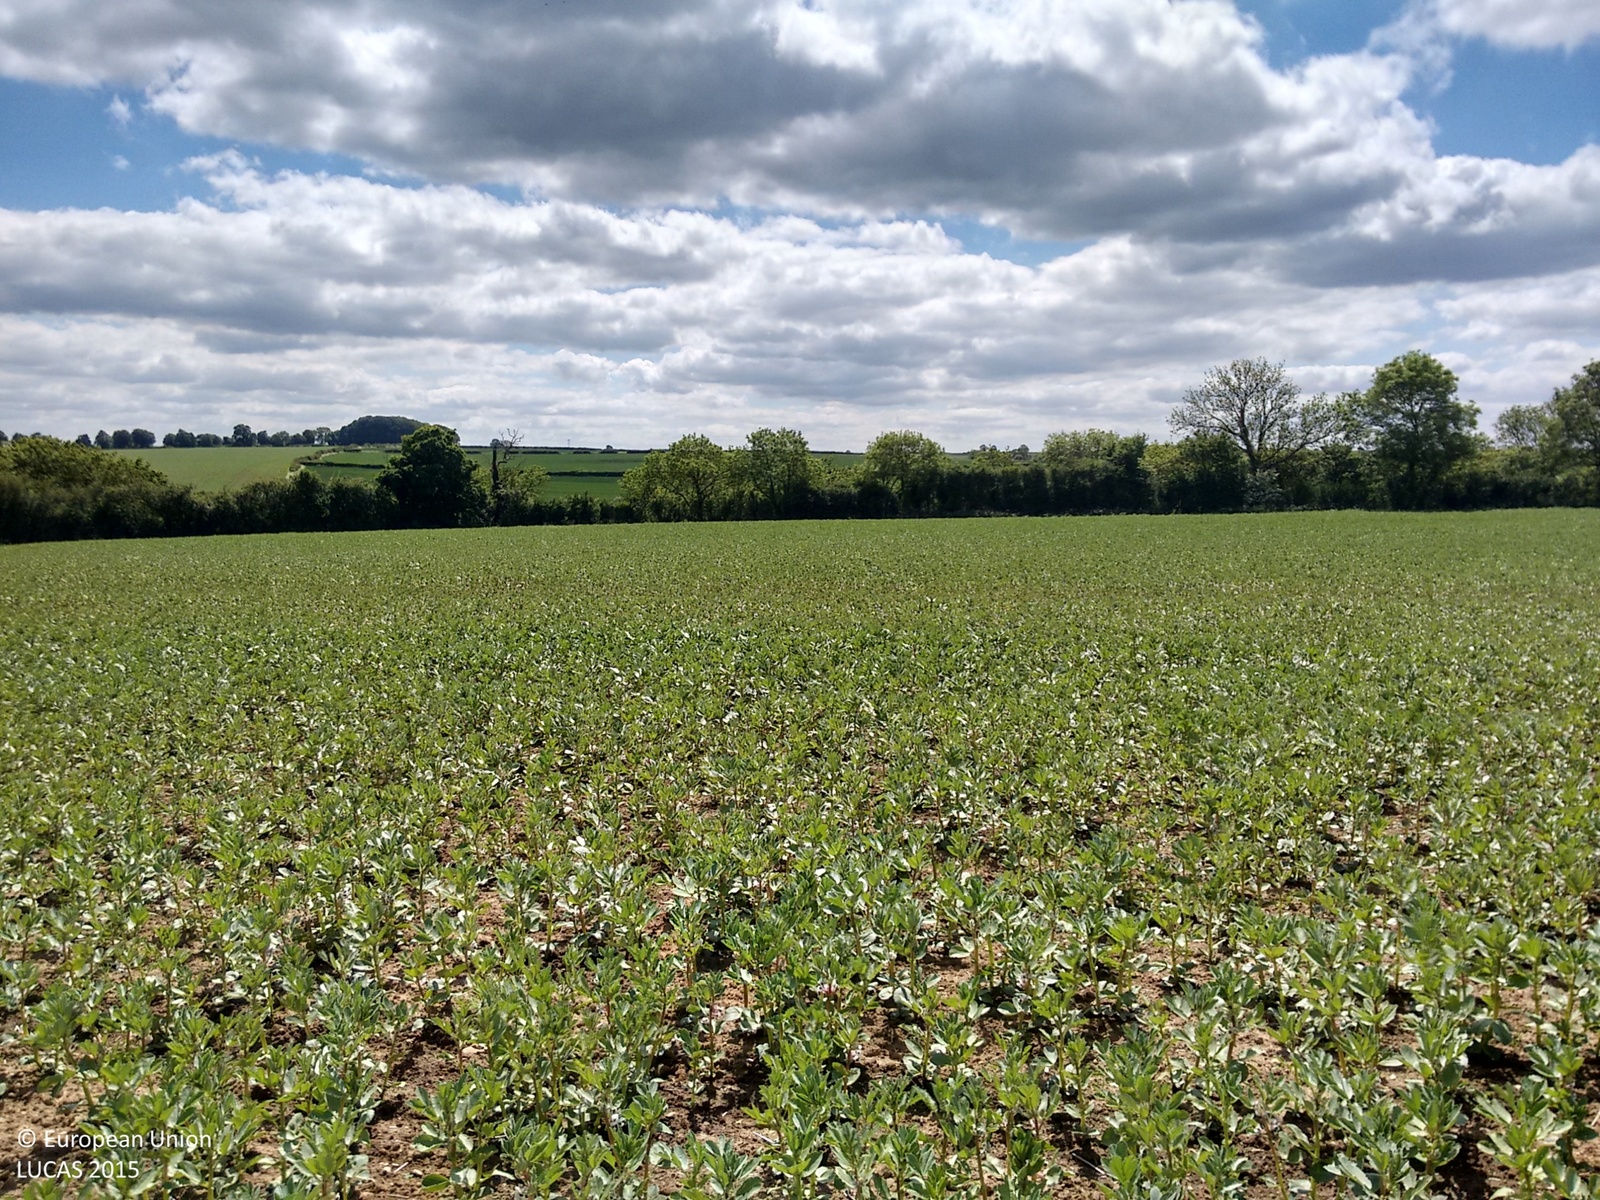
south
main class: Cropland
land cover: Dry pulses
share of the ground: 50 - 75 %
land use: Agriculture (excluding fallow land and kitchen gardens)
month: June
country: GB
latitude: 53.4823
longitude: -0.1447
